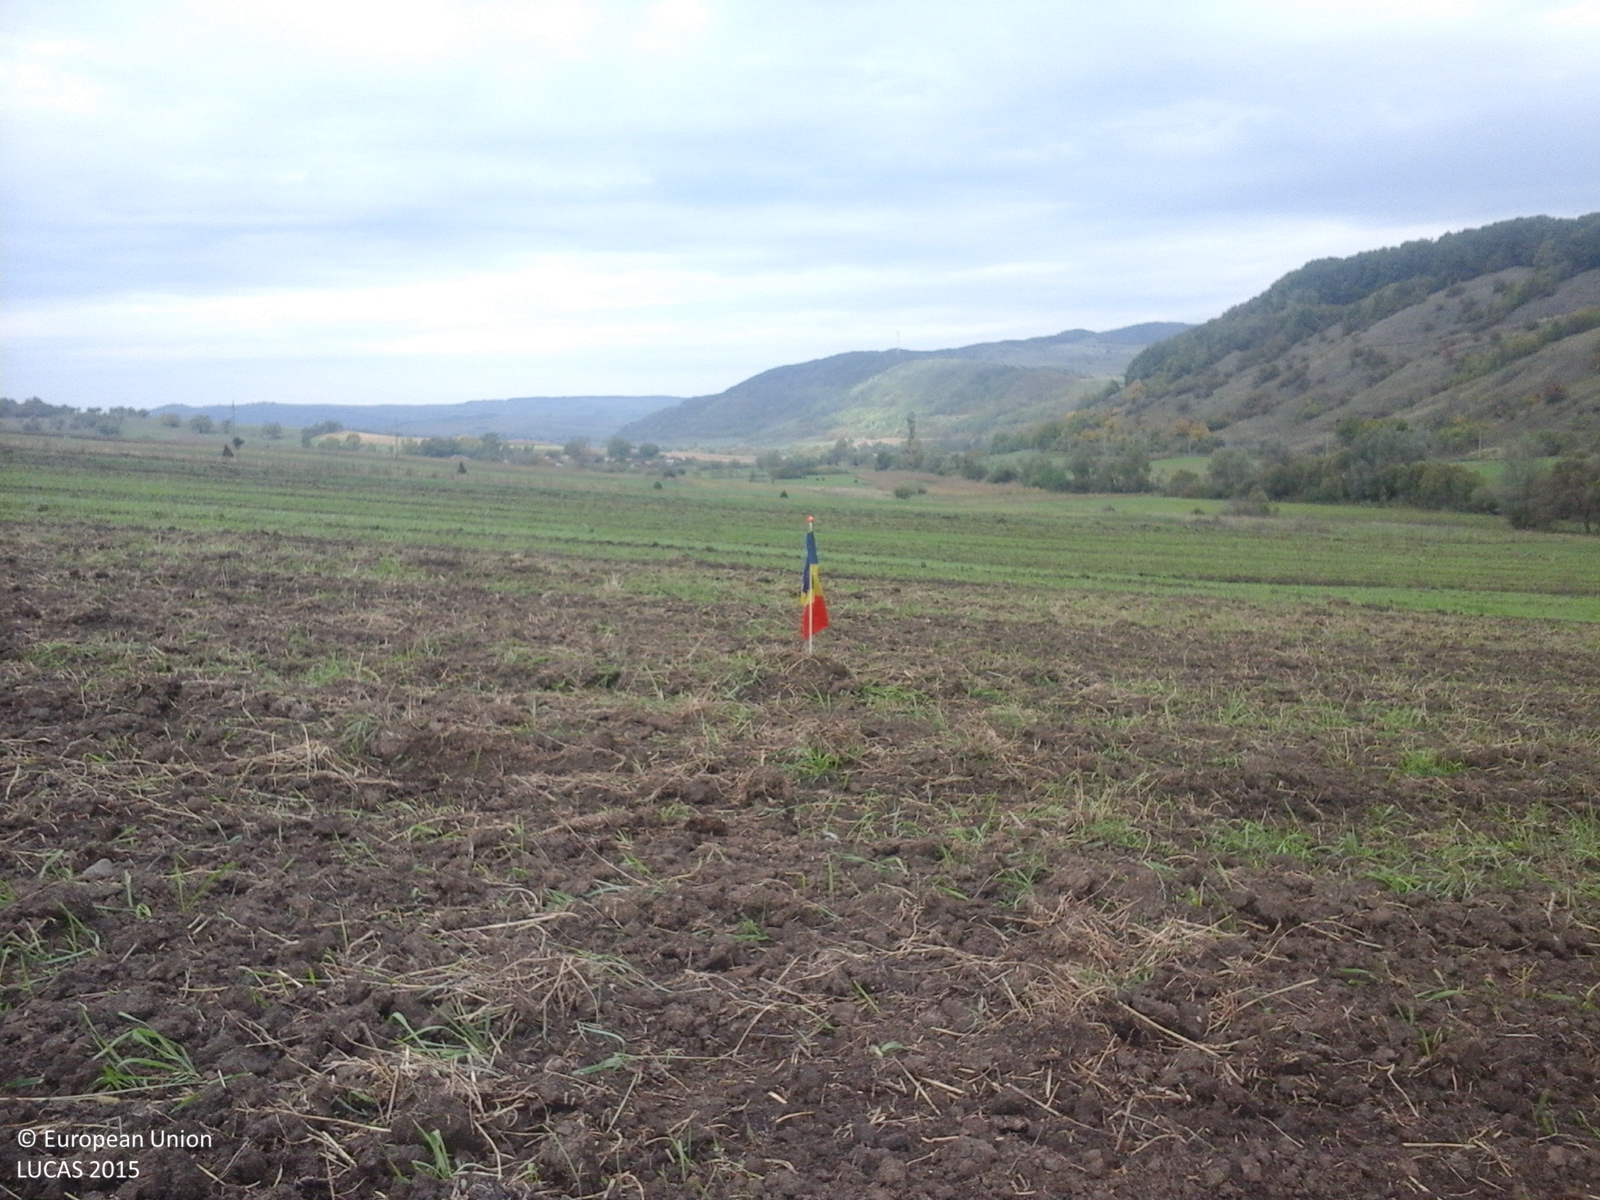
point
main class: Cropland
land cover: Common wheat
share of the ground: < 10 %
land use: Agriculture (excluding fallow land and kitchen gardens)
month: October
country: RO
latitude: 46.5453
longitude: 24.8971
